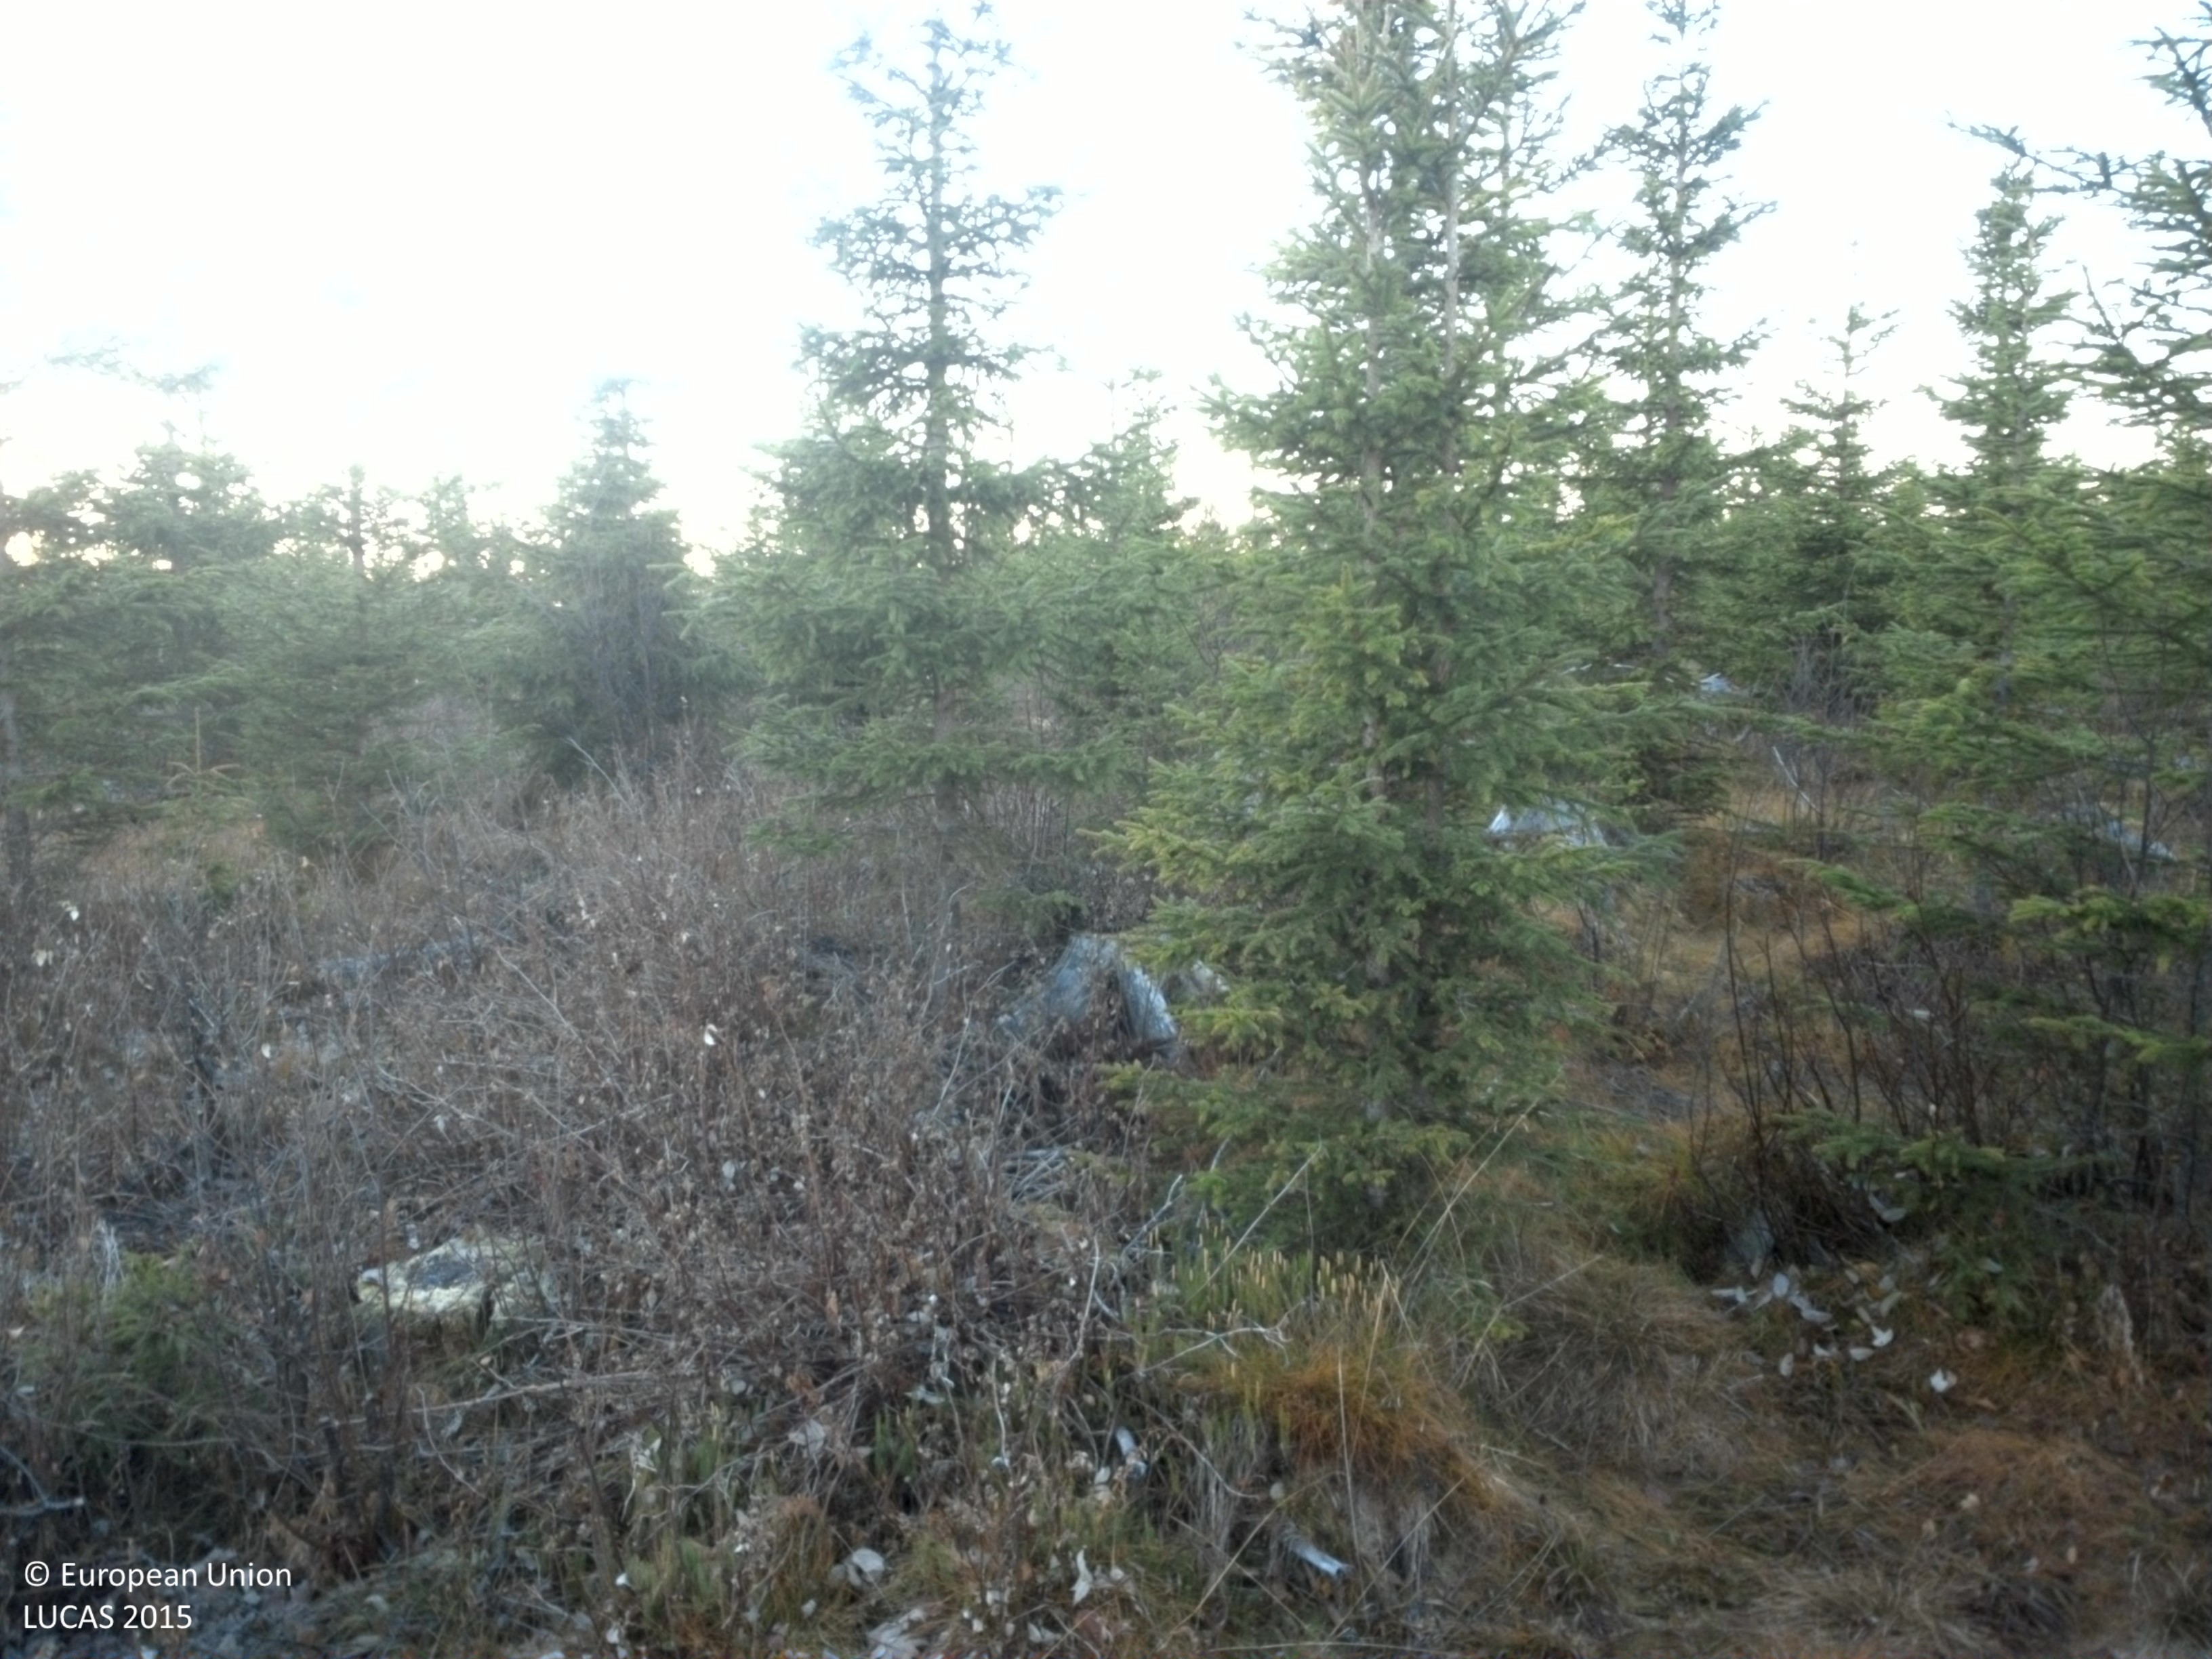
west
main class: Woodland
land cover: Spruce dominated coniferous woodland
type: boreal forest
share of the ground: 25 - 50 %
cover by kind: shrubs 35 %, herbaceous plants 35 %, coniferous forest trees 20 %, broadleaved forest trees 5 %, lichens and mosses 5 %
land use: Forestry
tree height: < 5 m
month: October
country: SE
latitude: 64.5055
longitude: 16.8181
